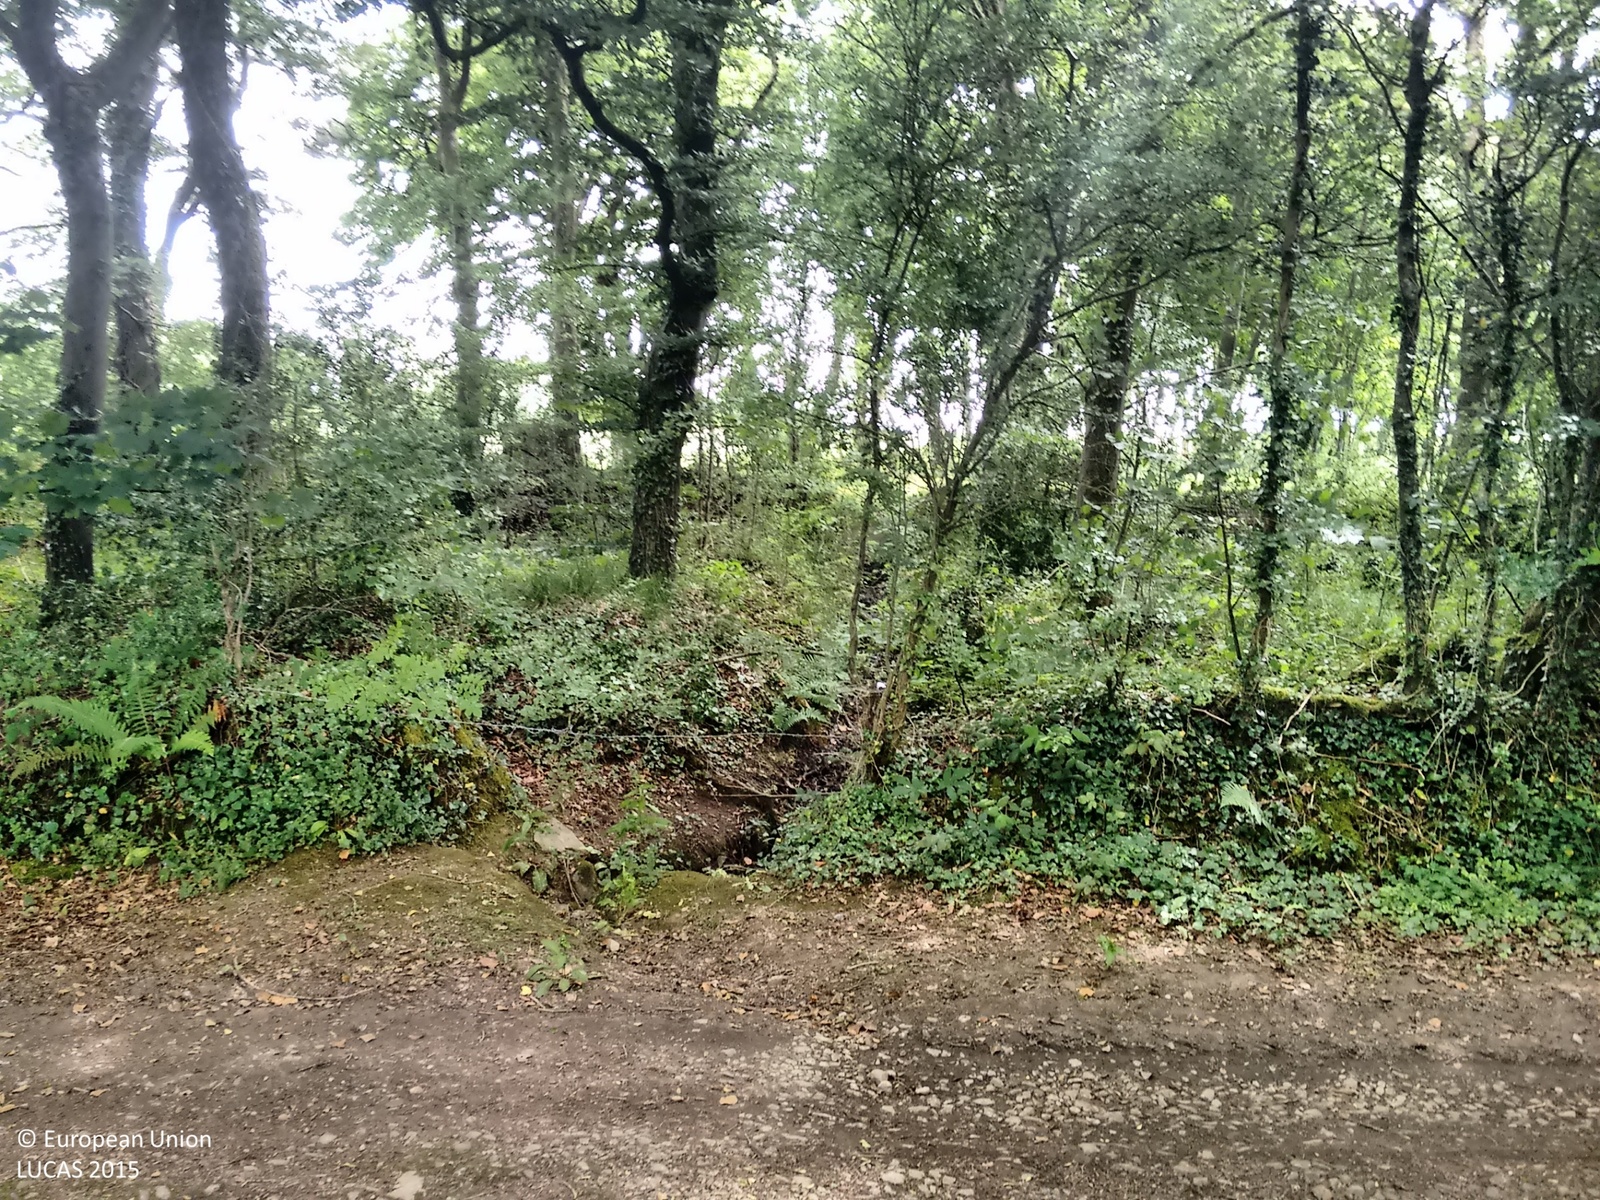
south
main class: Cropland
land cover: Oats
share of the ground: > 75 %
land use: Agriculture (excluding fallow land and kitchen gardens)
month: July
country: IE
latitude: 52.1685
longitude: -8.9097
